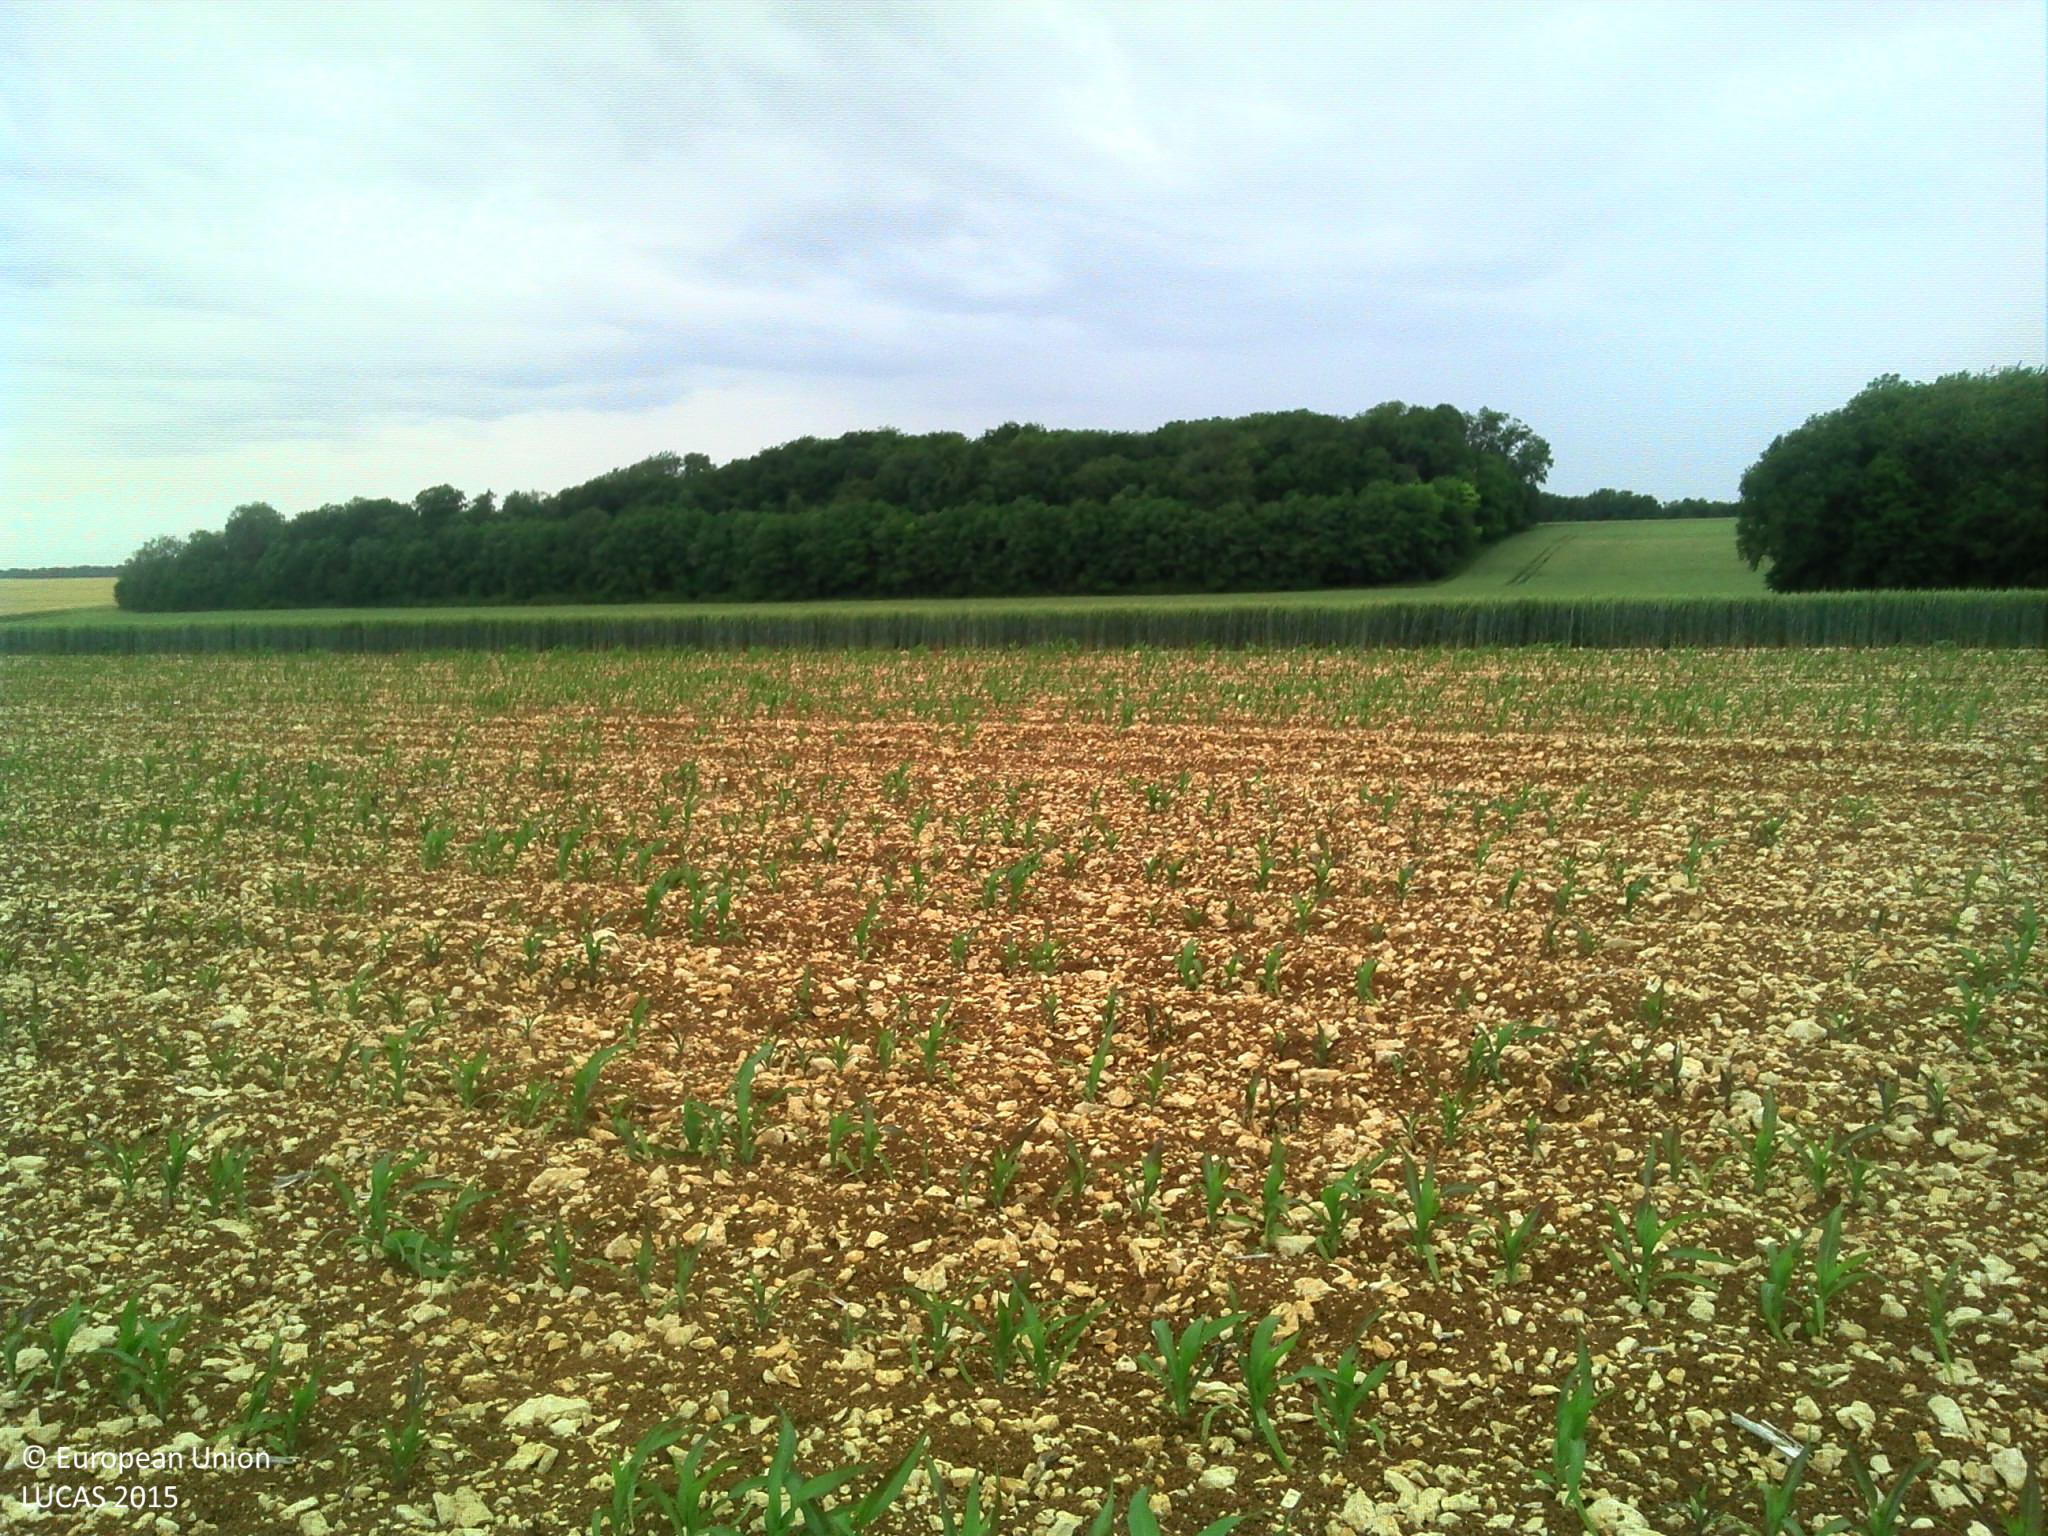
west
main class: Cropland
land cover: Maize
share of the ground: 10 - 25 %
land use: Agriculture (excluding fallow land and kitchen gardens)
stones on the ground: > 50 %
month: June
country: FR
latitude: 48.3430
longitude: 4.9660
